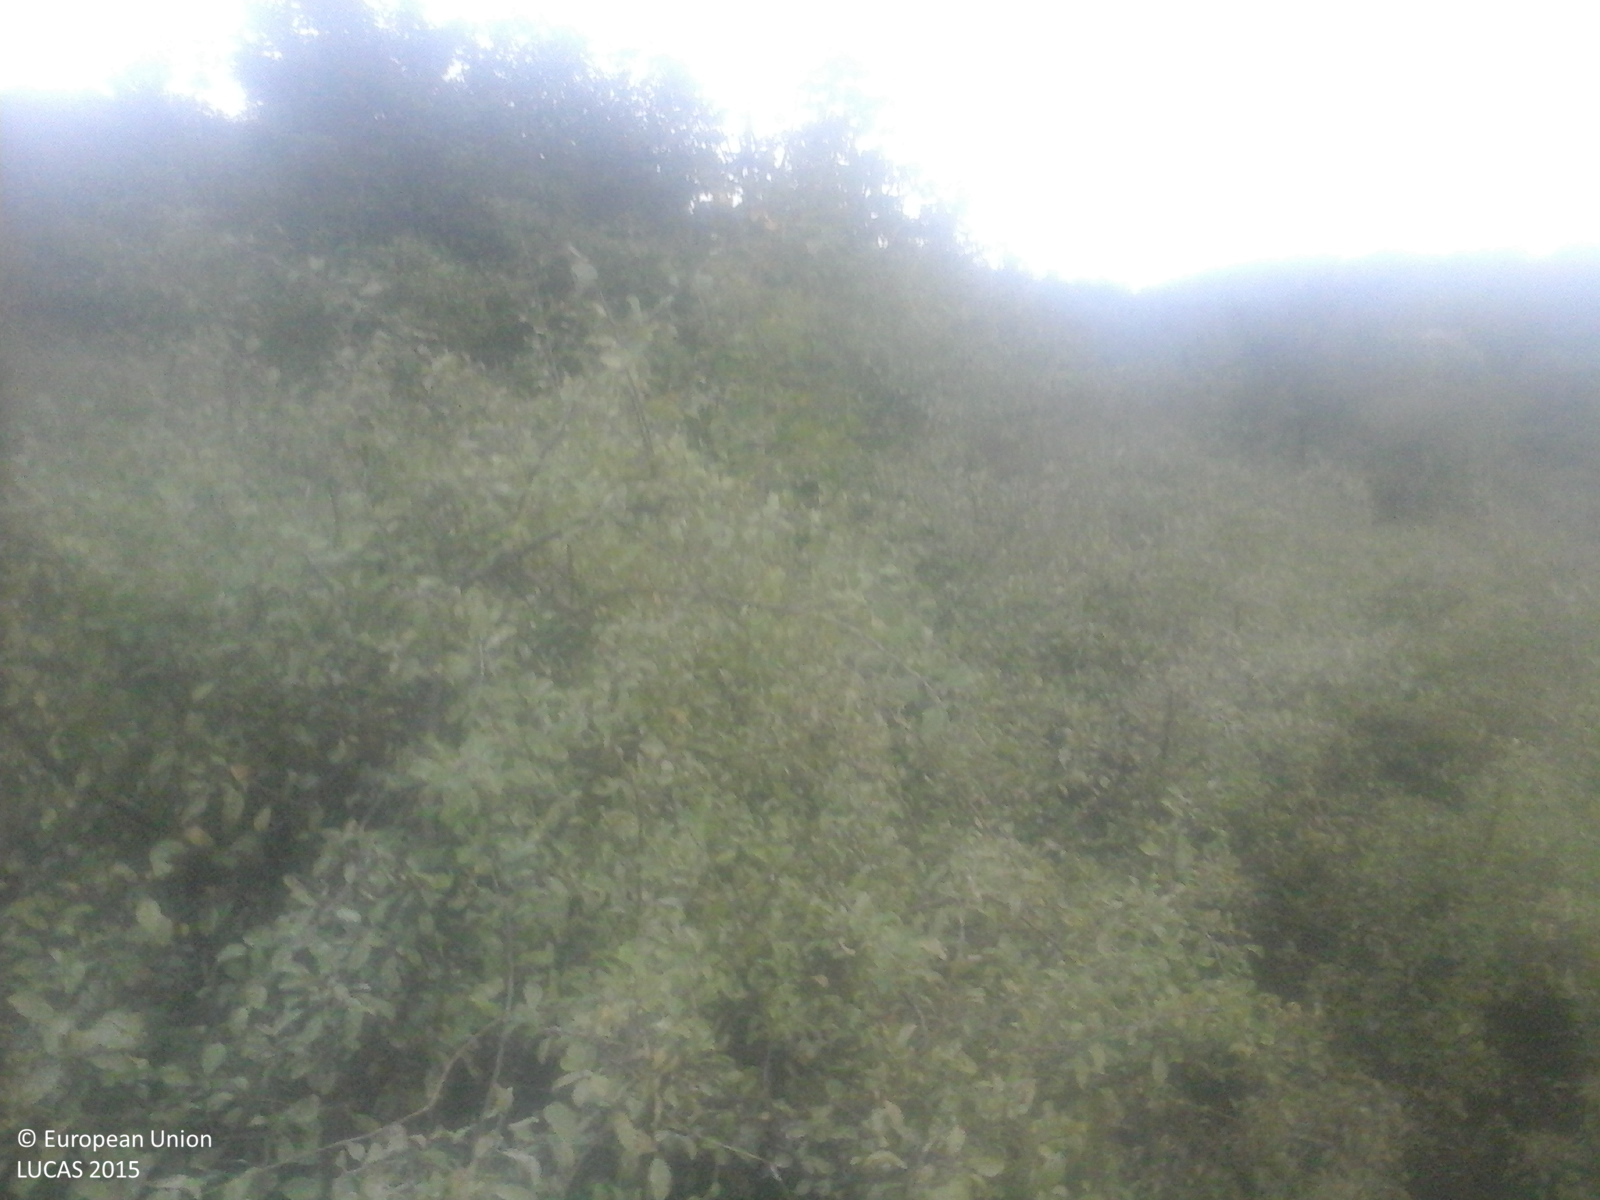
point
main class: Shrubland
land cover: Shrubland without tree cover
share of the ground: > 75 %
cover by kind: shrubs 100 %
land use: Semi-natural and natural areas not in use
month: September
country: RO
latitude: 44.6723
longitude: 23.3348
